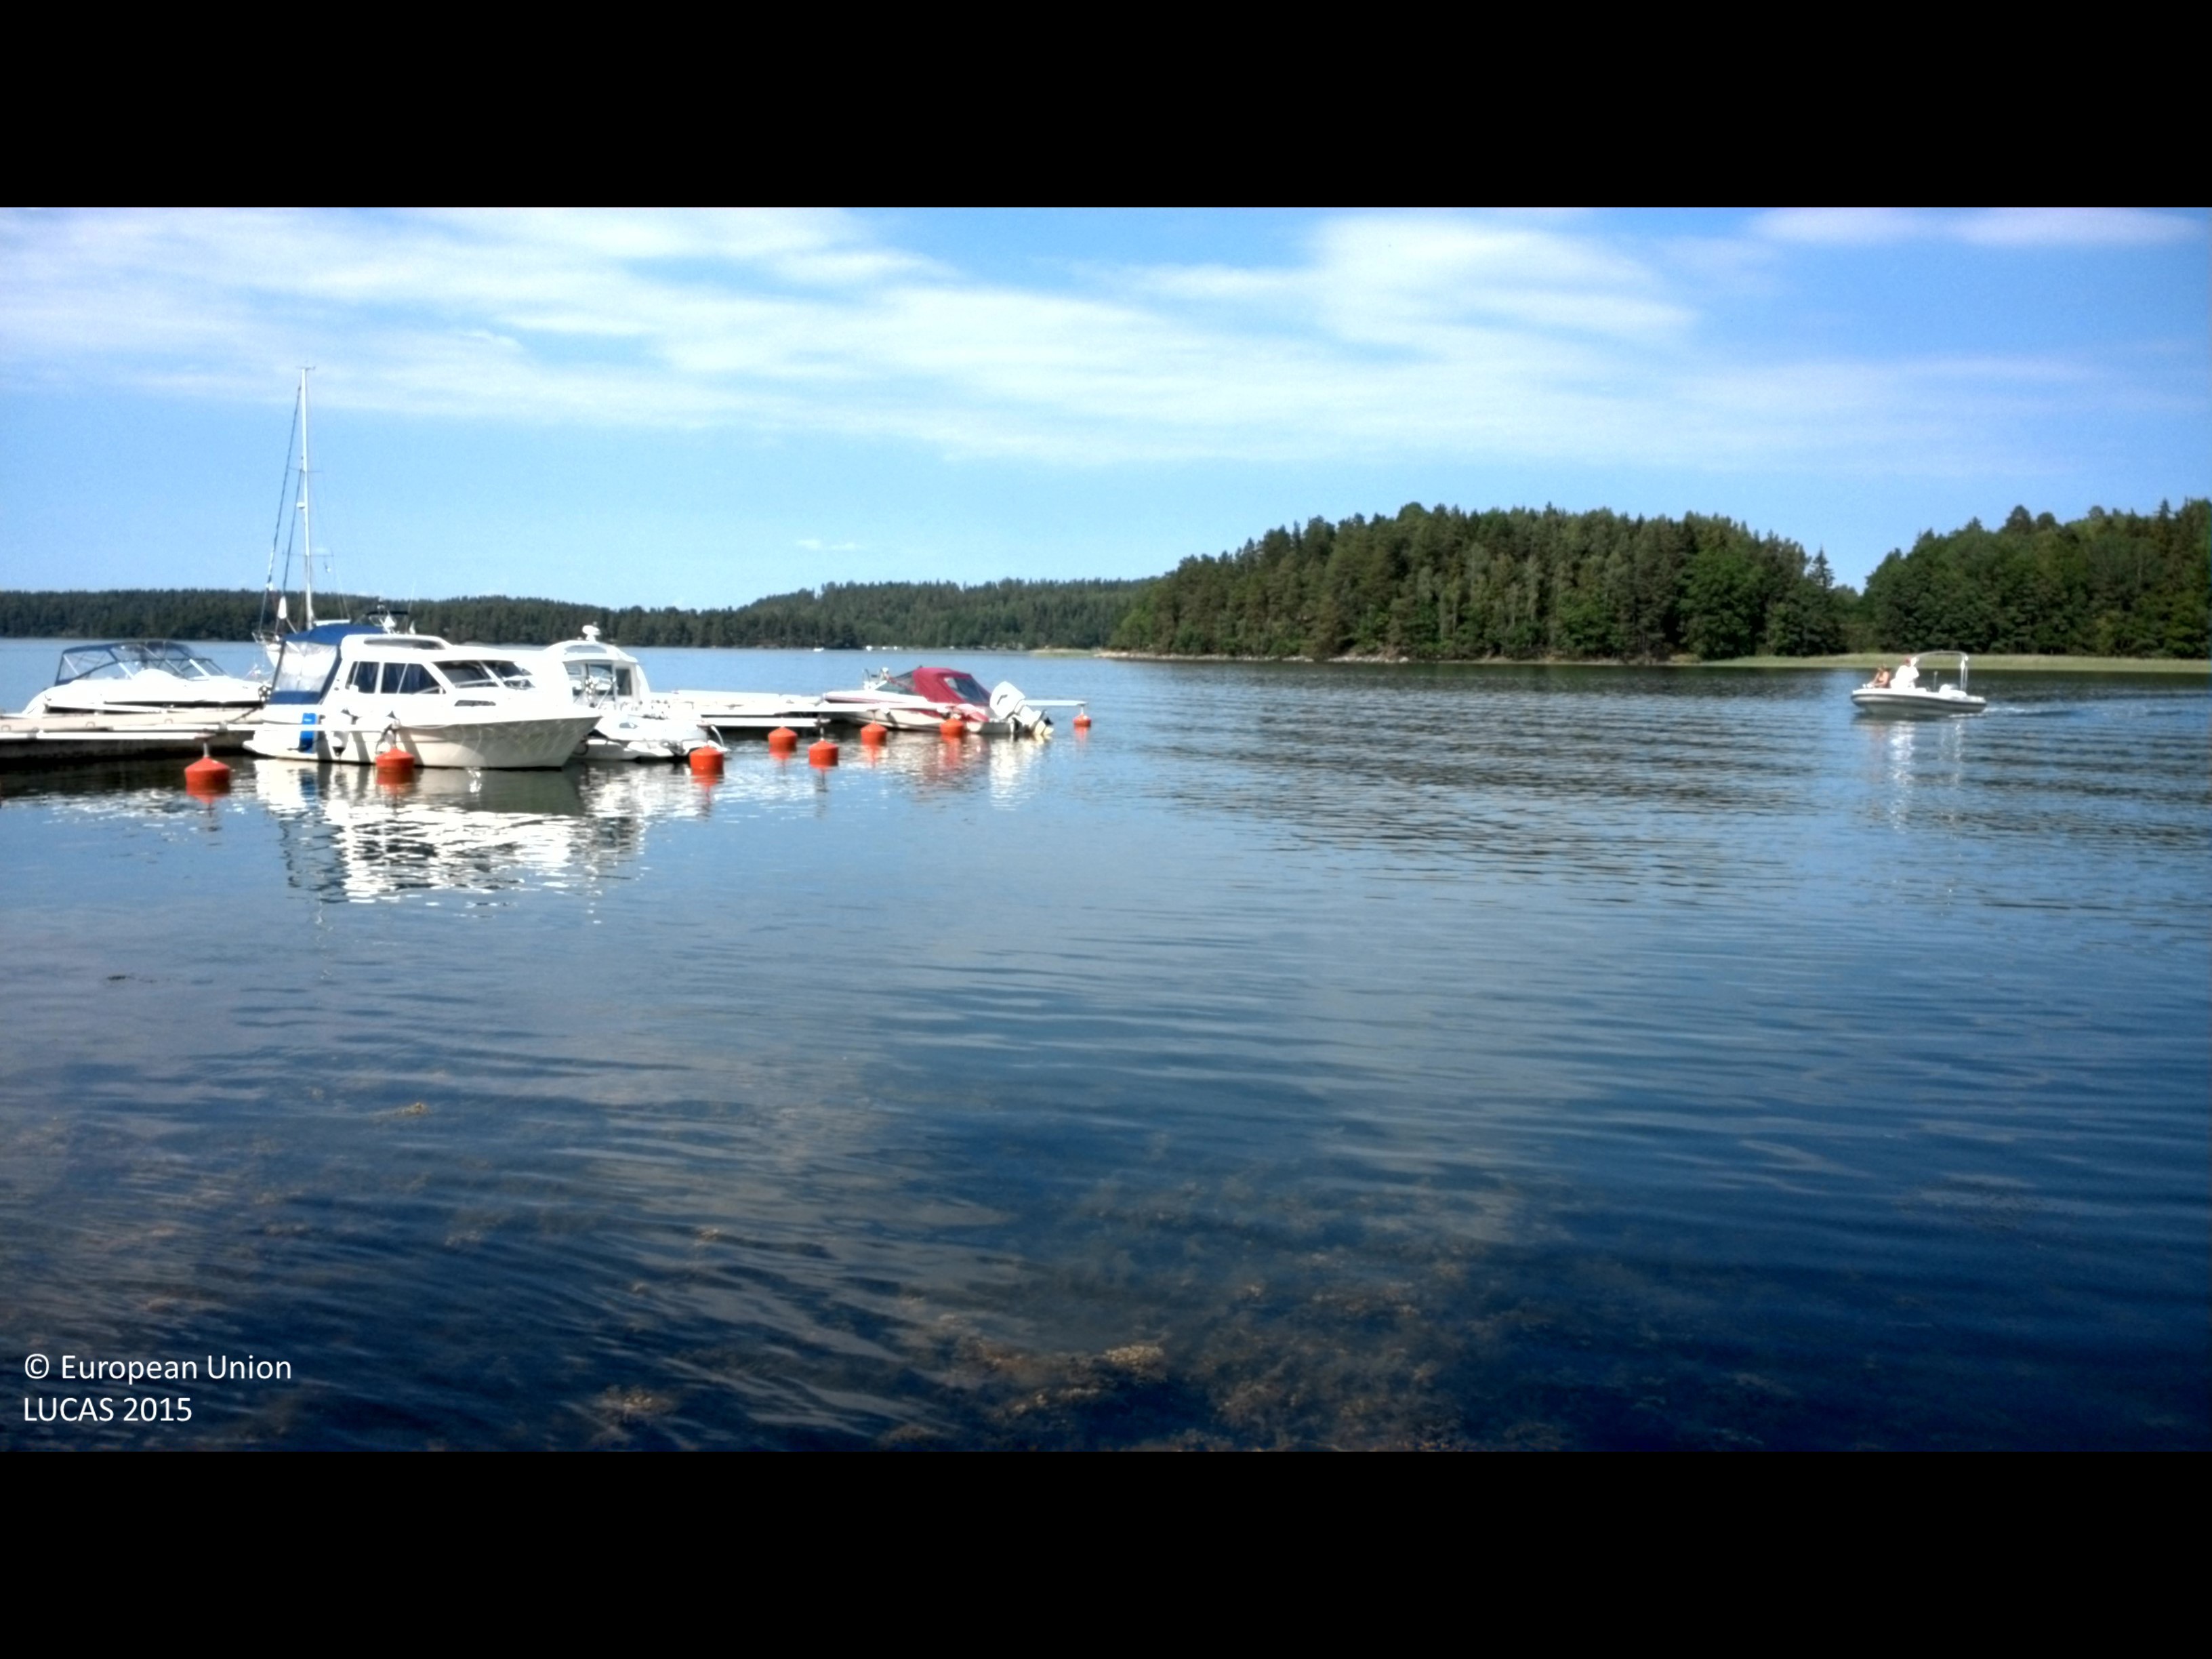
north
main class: Woodland
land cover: Broadleaved woodland
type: boreal forest
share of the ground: 50 - 75 %
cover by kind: broadleaved forest trees 65 %, shrubs 25 %, coniferous forest trees 5 %
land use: Amenities, museums, leisure
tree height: > 5 m
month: July
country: SE
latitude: 58.3229
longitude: 16.7071
